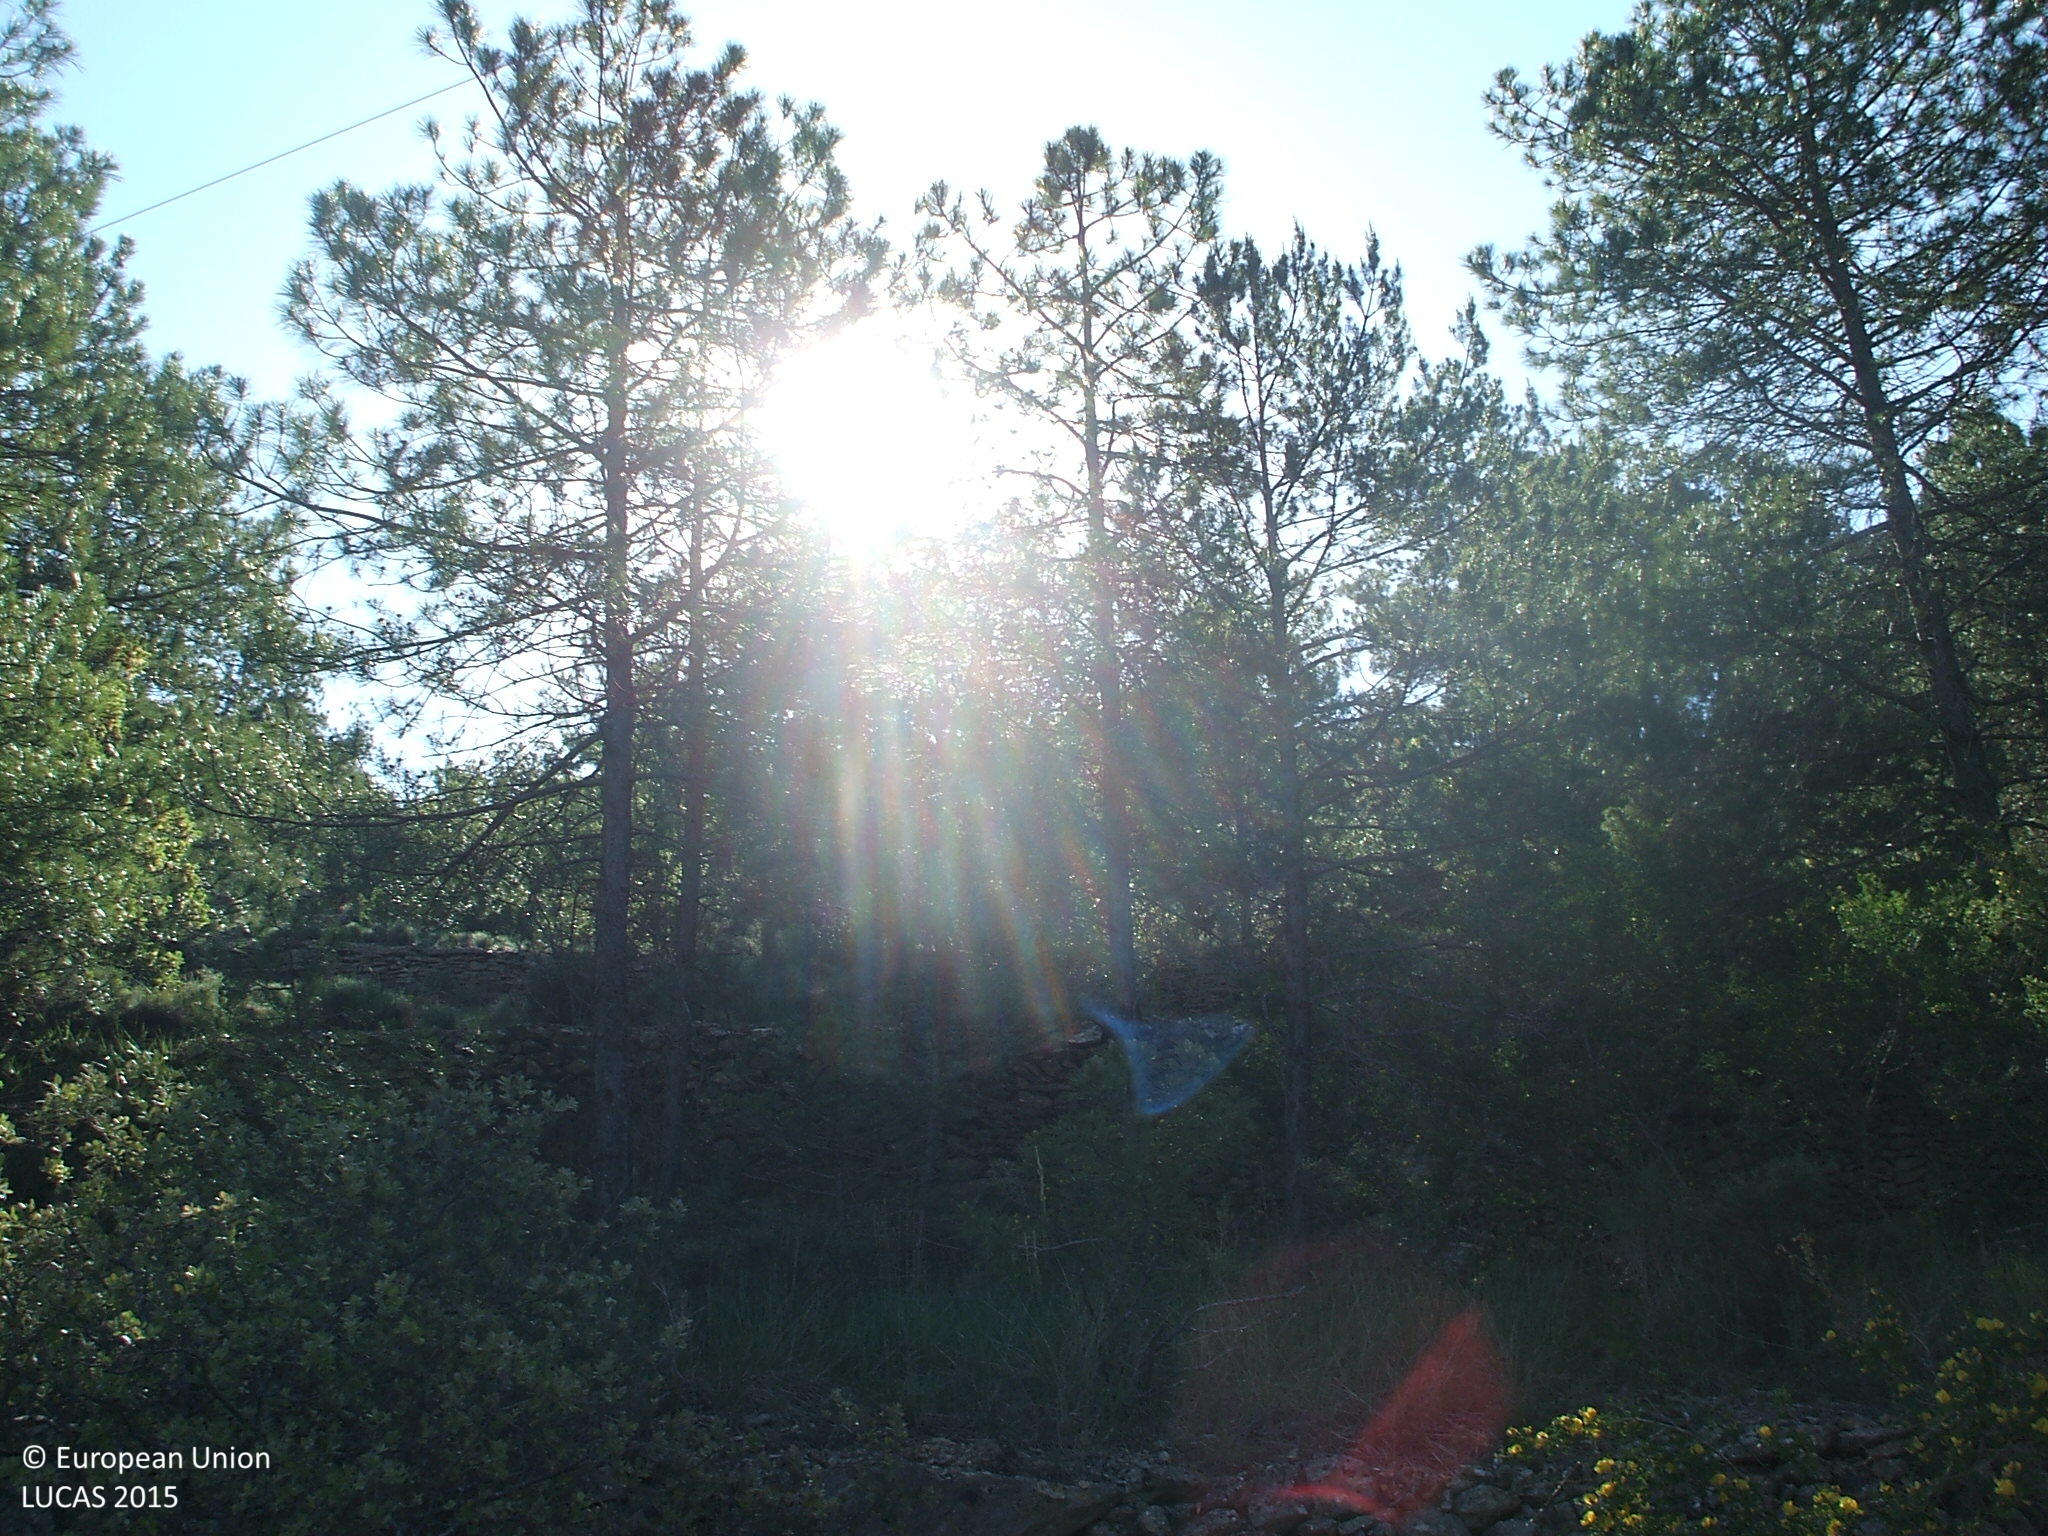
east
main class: Woodland
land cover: Pine dominated mixed woodland
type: coniferous forest of the mediterranean region
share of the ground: 50 - 75 %
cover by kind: herbaceous plants 40 %, coniferous forest trees 35 %, broadleaved forest trees 25 %
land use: Semi-natural and natural areas not in use
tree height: > 5 m
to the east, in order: Pine dominated mixed woodland; Ditches and canals; Pine dominated mixed woodland; Electric lines; Pine dominated mixed woodland; Dry stone walls; Pine dominated mixed woodland; Dry stone walls; Pine dominated mixed woodland; Dry stone walls; Pine dominated mixed woodland; Dry stone walls; Pine dominated mixed woodland; Dry stone walls; Pine dominated mixed woodland; Dry stone walls; Pine dominated mixed woodland; Dry stone walls; Pine dominated mixed woodland; Dry stone walls; Pine dominated mixed woodland; Dry stone walls; Pine dominated mixed woodland; Dry stone walls; Pine dominated mixed woodland; Dry stone walls; Shrubland with sparse tree cover; Dry stone walls; Pine dominated mixed woodland; Tracks; Shrubland with sparse tree cover; Dry stone walls; Common wheat; Dry stone walls; Common wheat; Dry stone walls; Common wheat; Dry stone walls; Shruby margins; Spontaneously vegetated surfaces
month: May
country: ES
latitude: 40.5674
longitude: -0.2482
